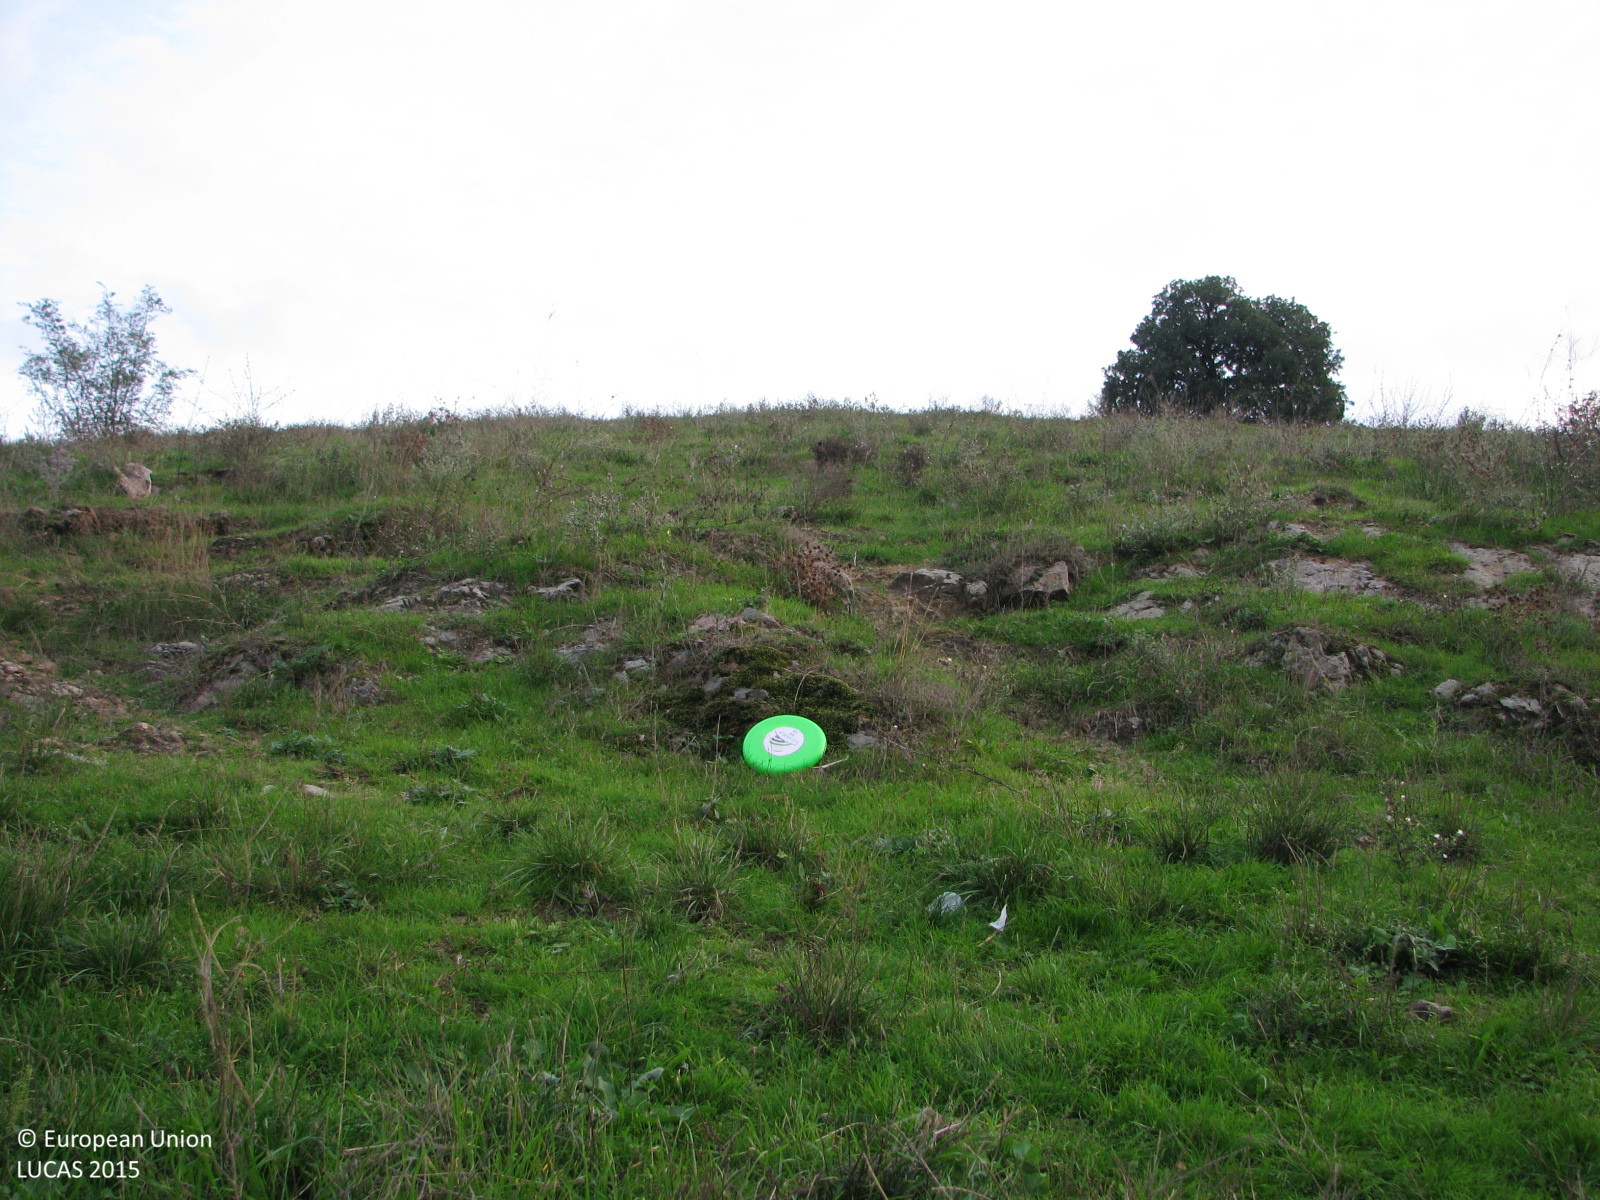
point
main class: Grassland
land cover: Grassland without tree/shrub cover
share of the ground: > 75 %
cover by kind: herbaceous plants 85 %, unconsolidated bare surface 15 %
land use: Agriculture (excluding fallow land and kitchen gardens)
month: October
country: BG
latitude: 42.2445
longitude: 26.5109
